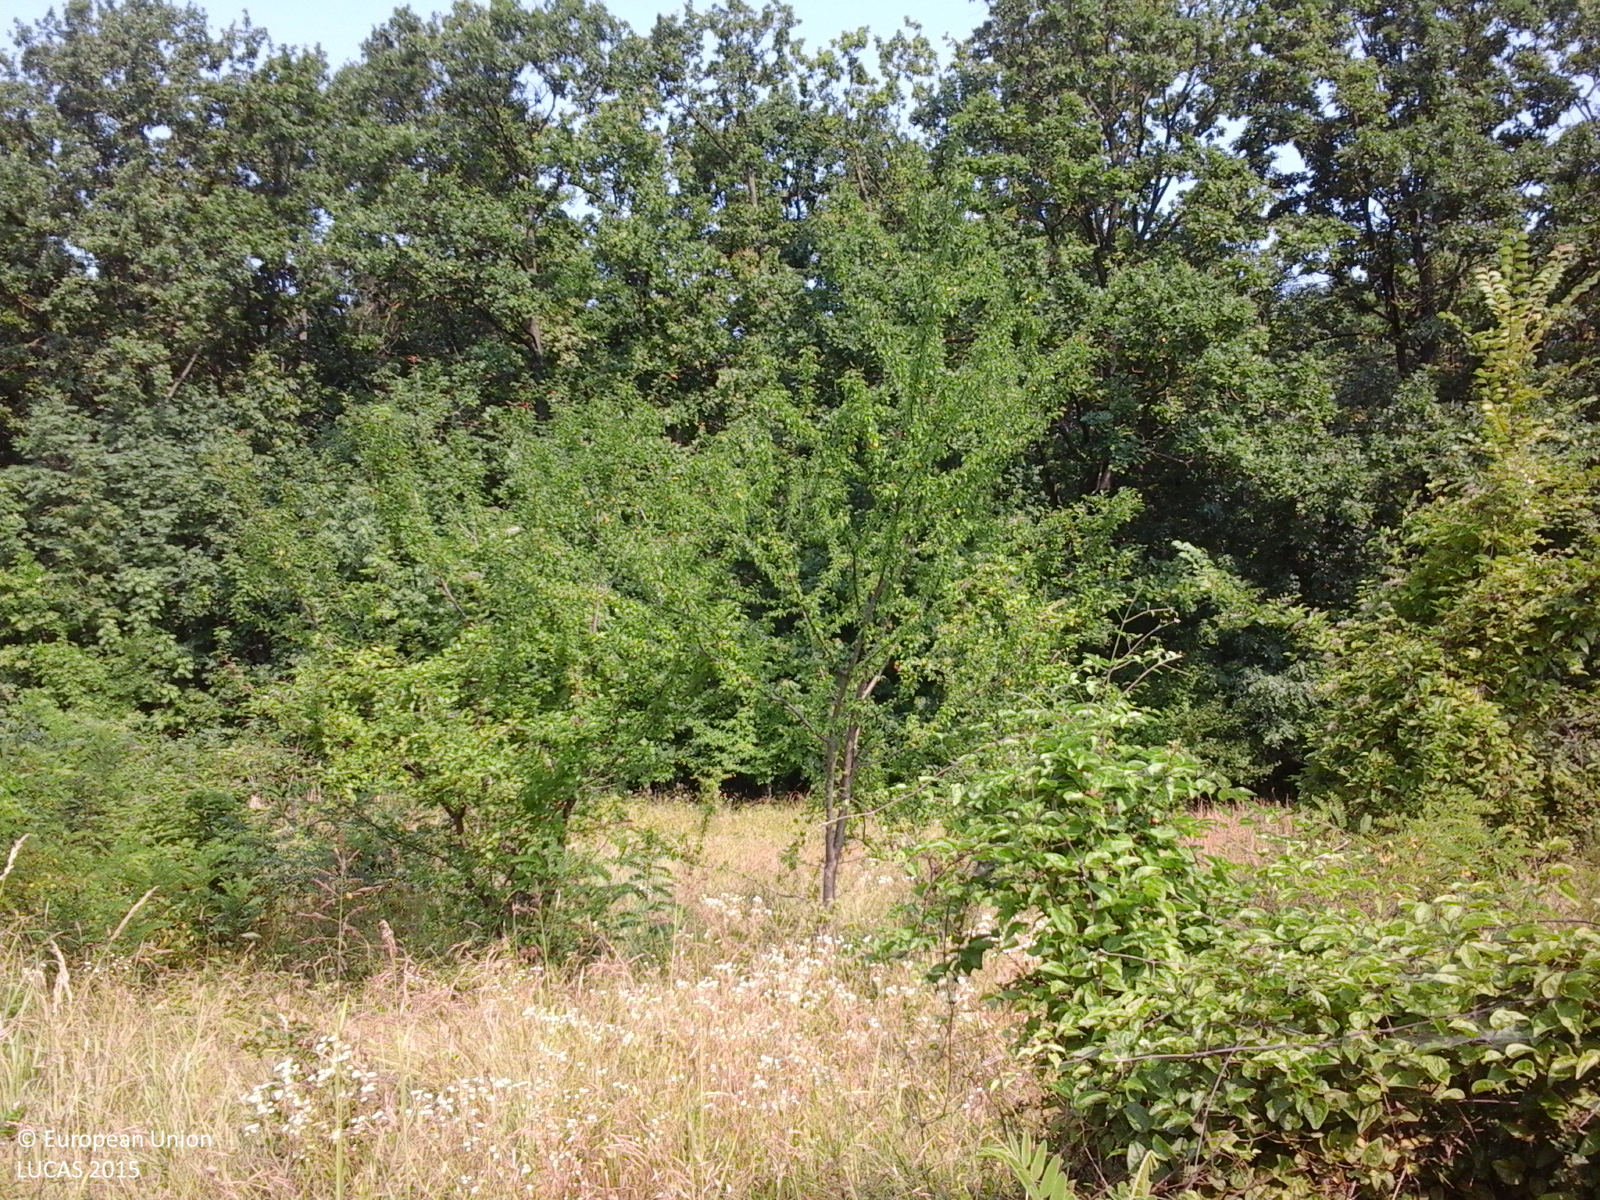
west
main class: Grassland
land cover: Grassland with sparse tree/shrub cover
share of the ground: > 75 %
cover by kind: herbaceous plants 85 %, shrubs 10 %, broadleaved forest trees 5 %
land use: Forestry
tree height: < 5 m
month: July
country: RO
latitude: 44.7913
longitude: 26.3316
